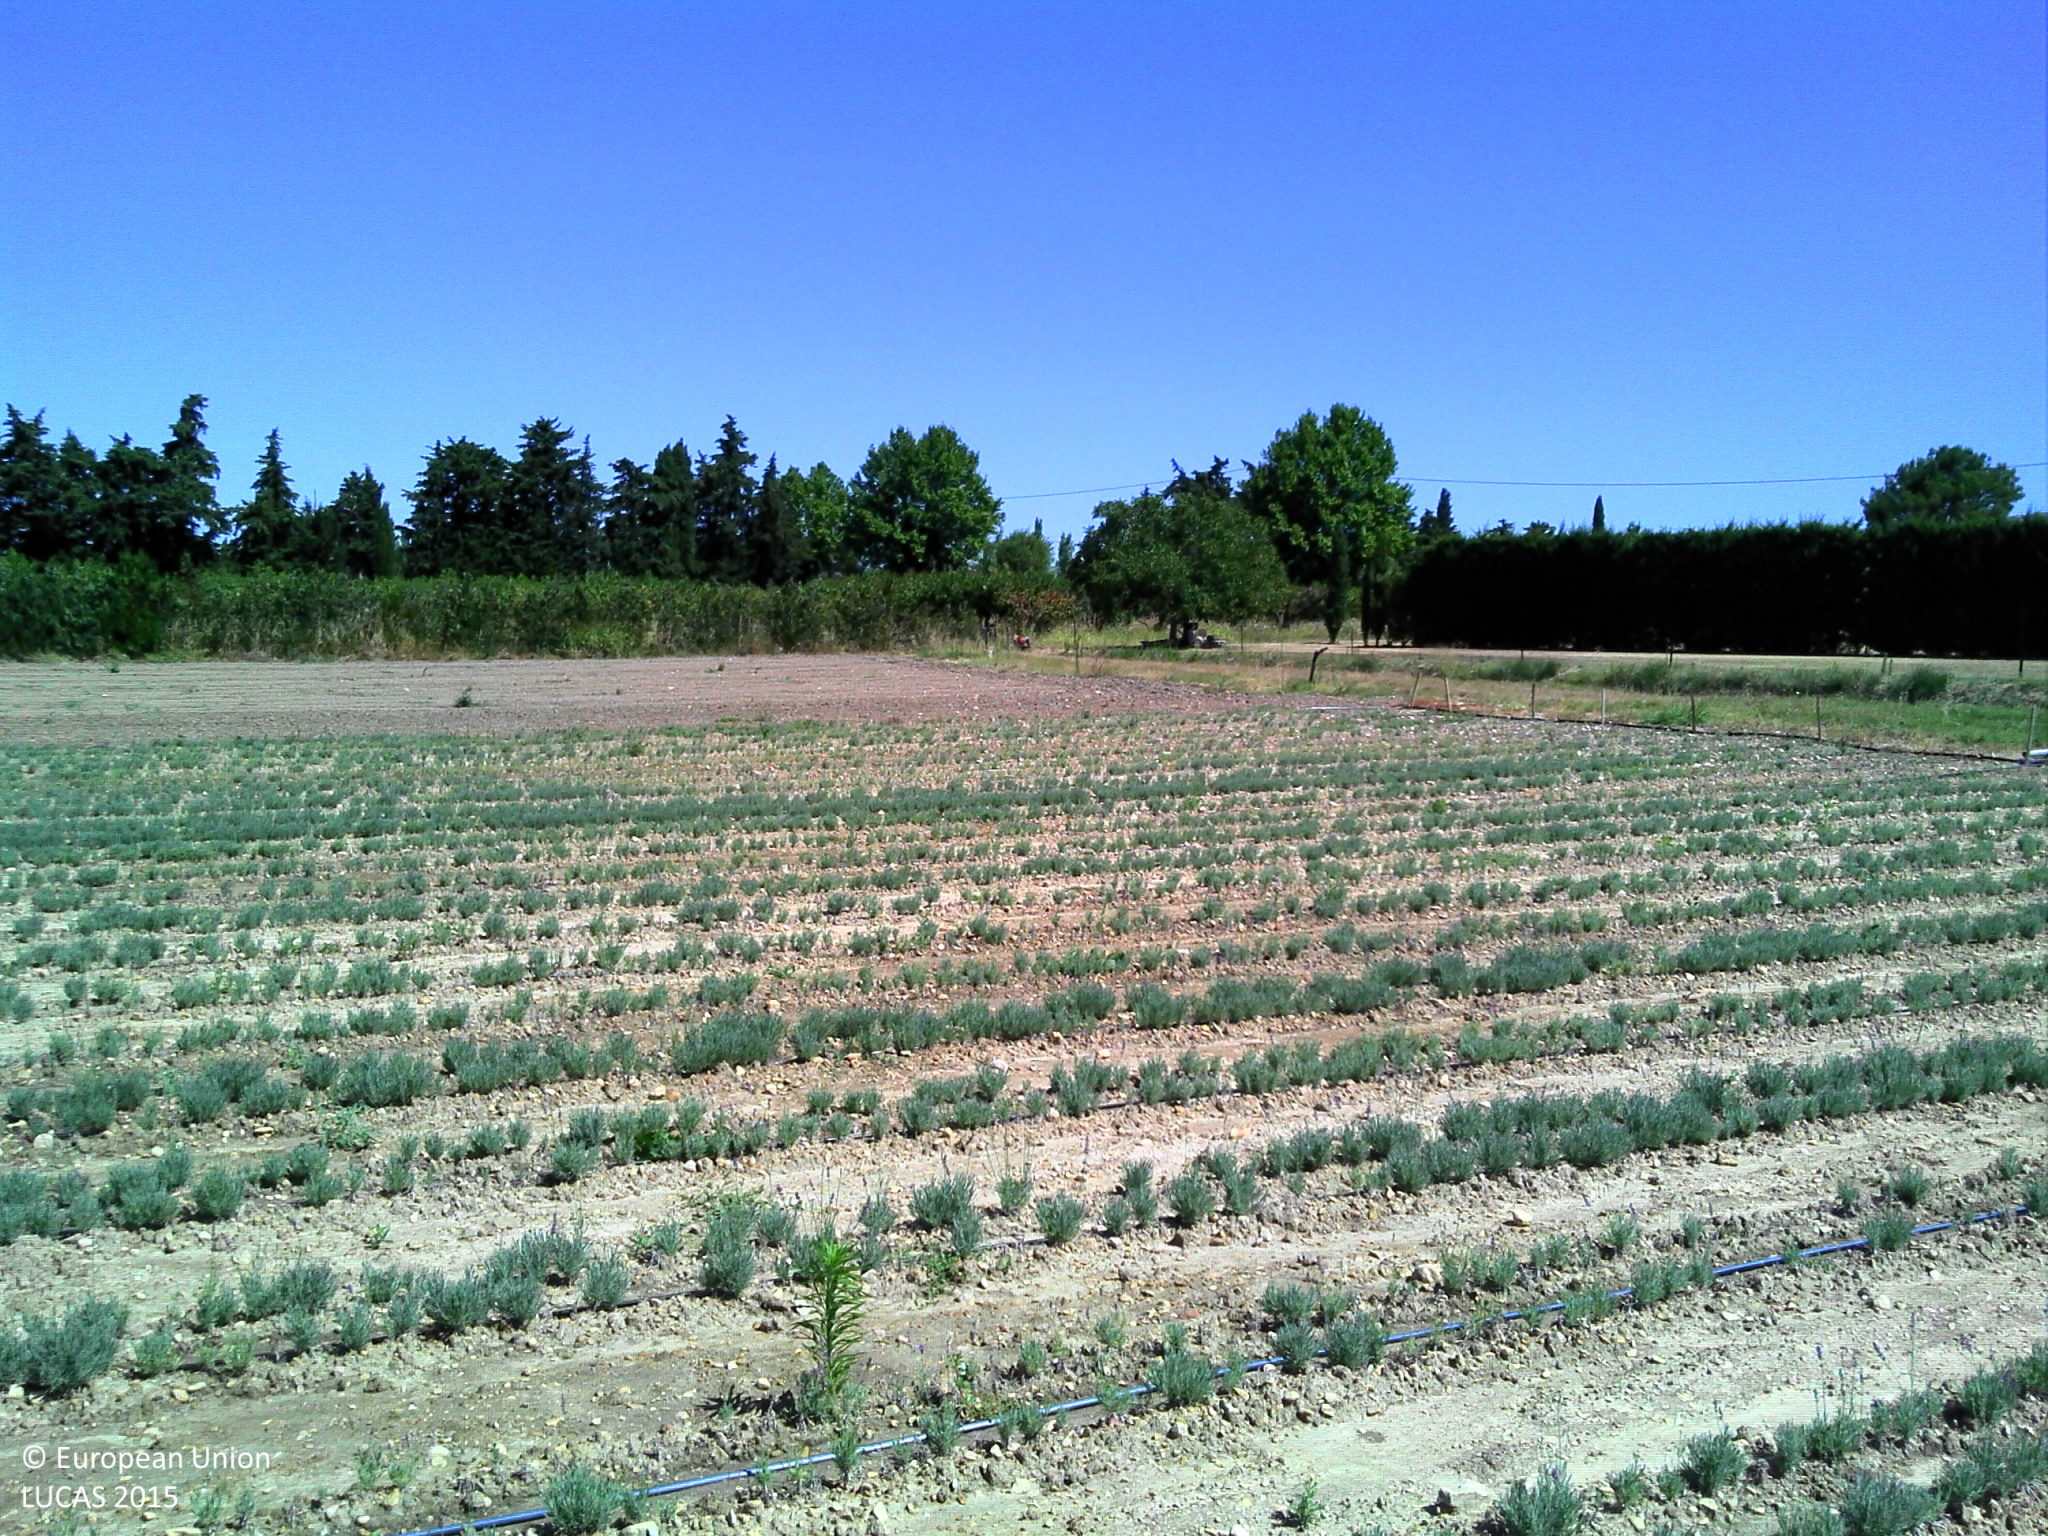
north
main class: Cropland
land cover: Permanent industrial crops
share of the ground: 25 - 50 %
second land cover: Other bare soil
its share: > 75 %
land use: Agriculture (excluding fallow land and kitchen gardens)
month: July
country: FR
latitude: 43.8911
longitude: 5.0917
